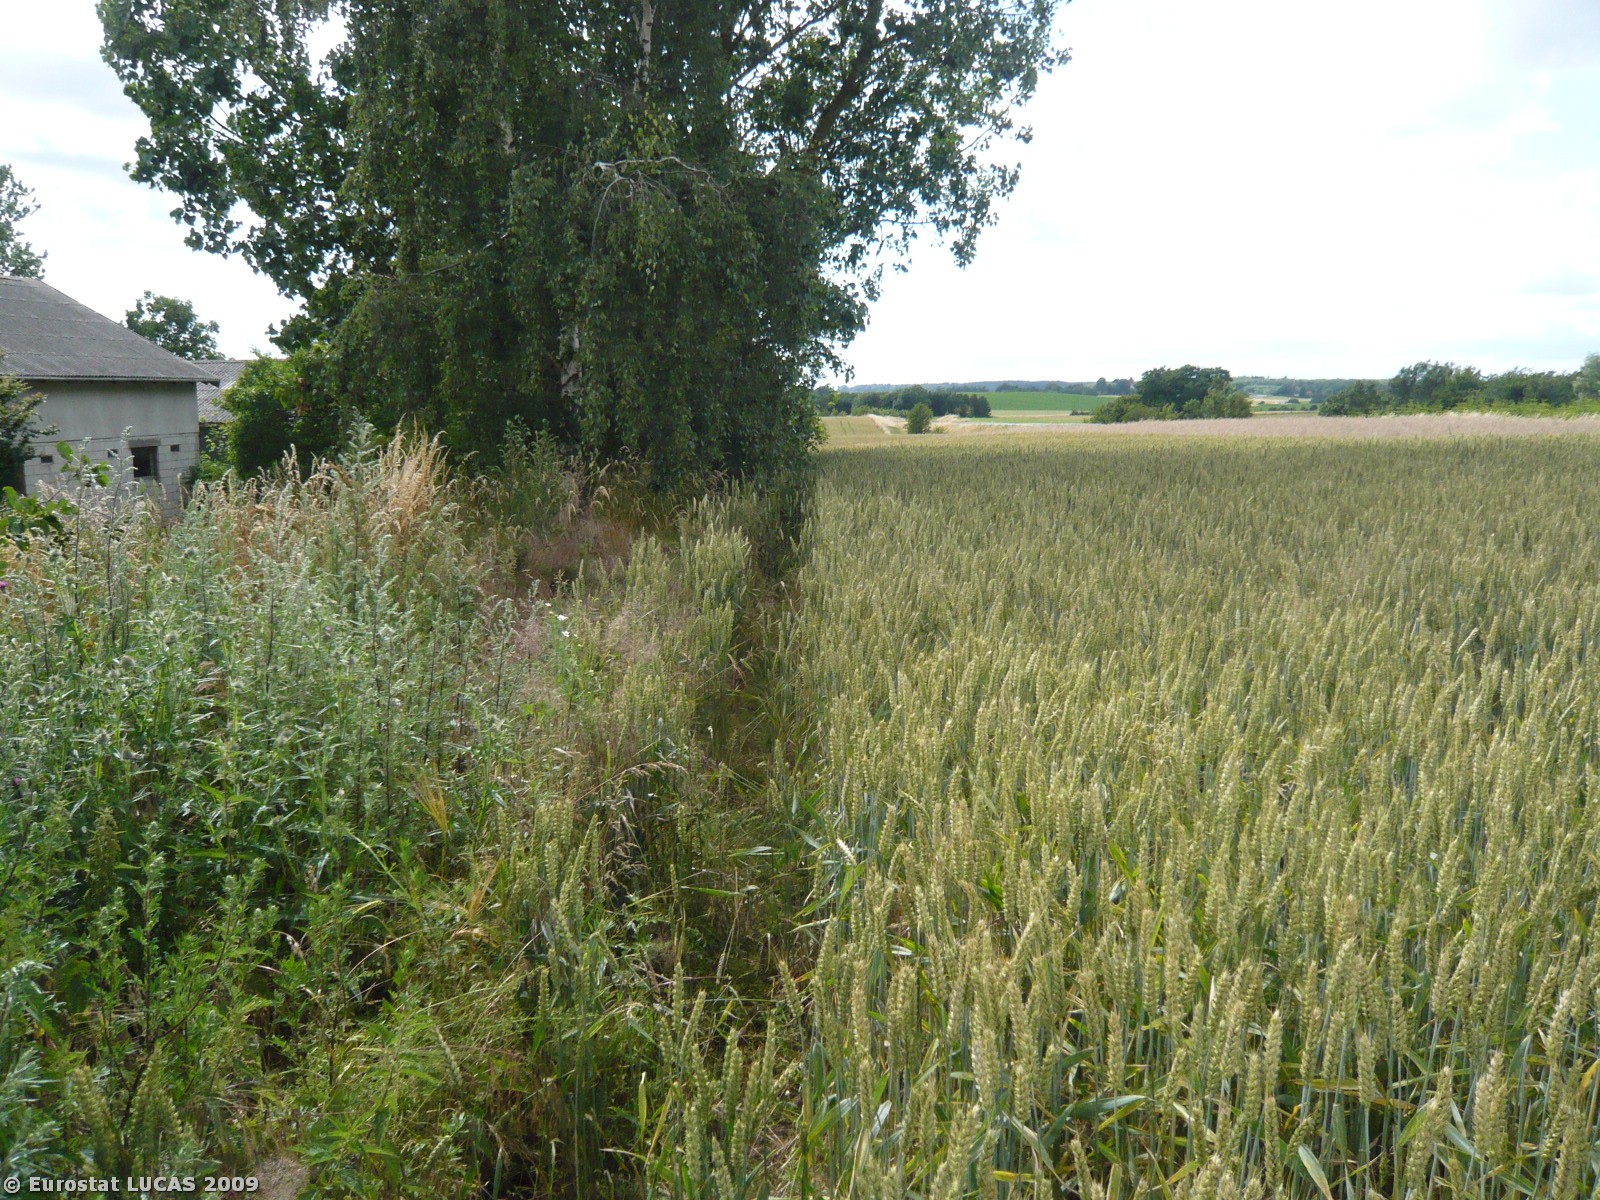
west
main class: Cropland
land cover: Common wheat
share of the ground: > 75 %
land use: Agriculture (excluding fallow land and kitchen gardens)
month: July
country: DK
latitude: 55.5321
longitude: 11.4721
